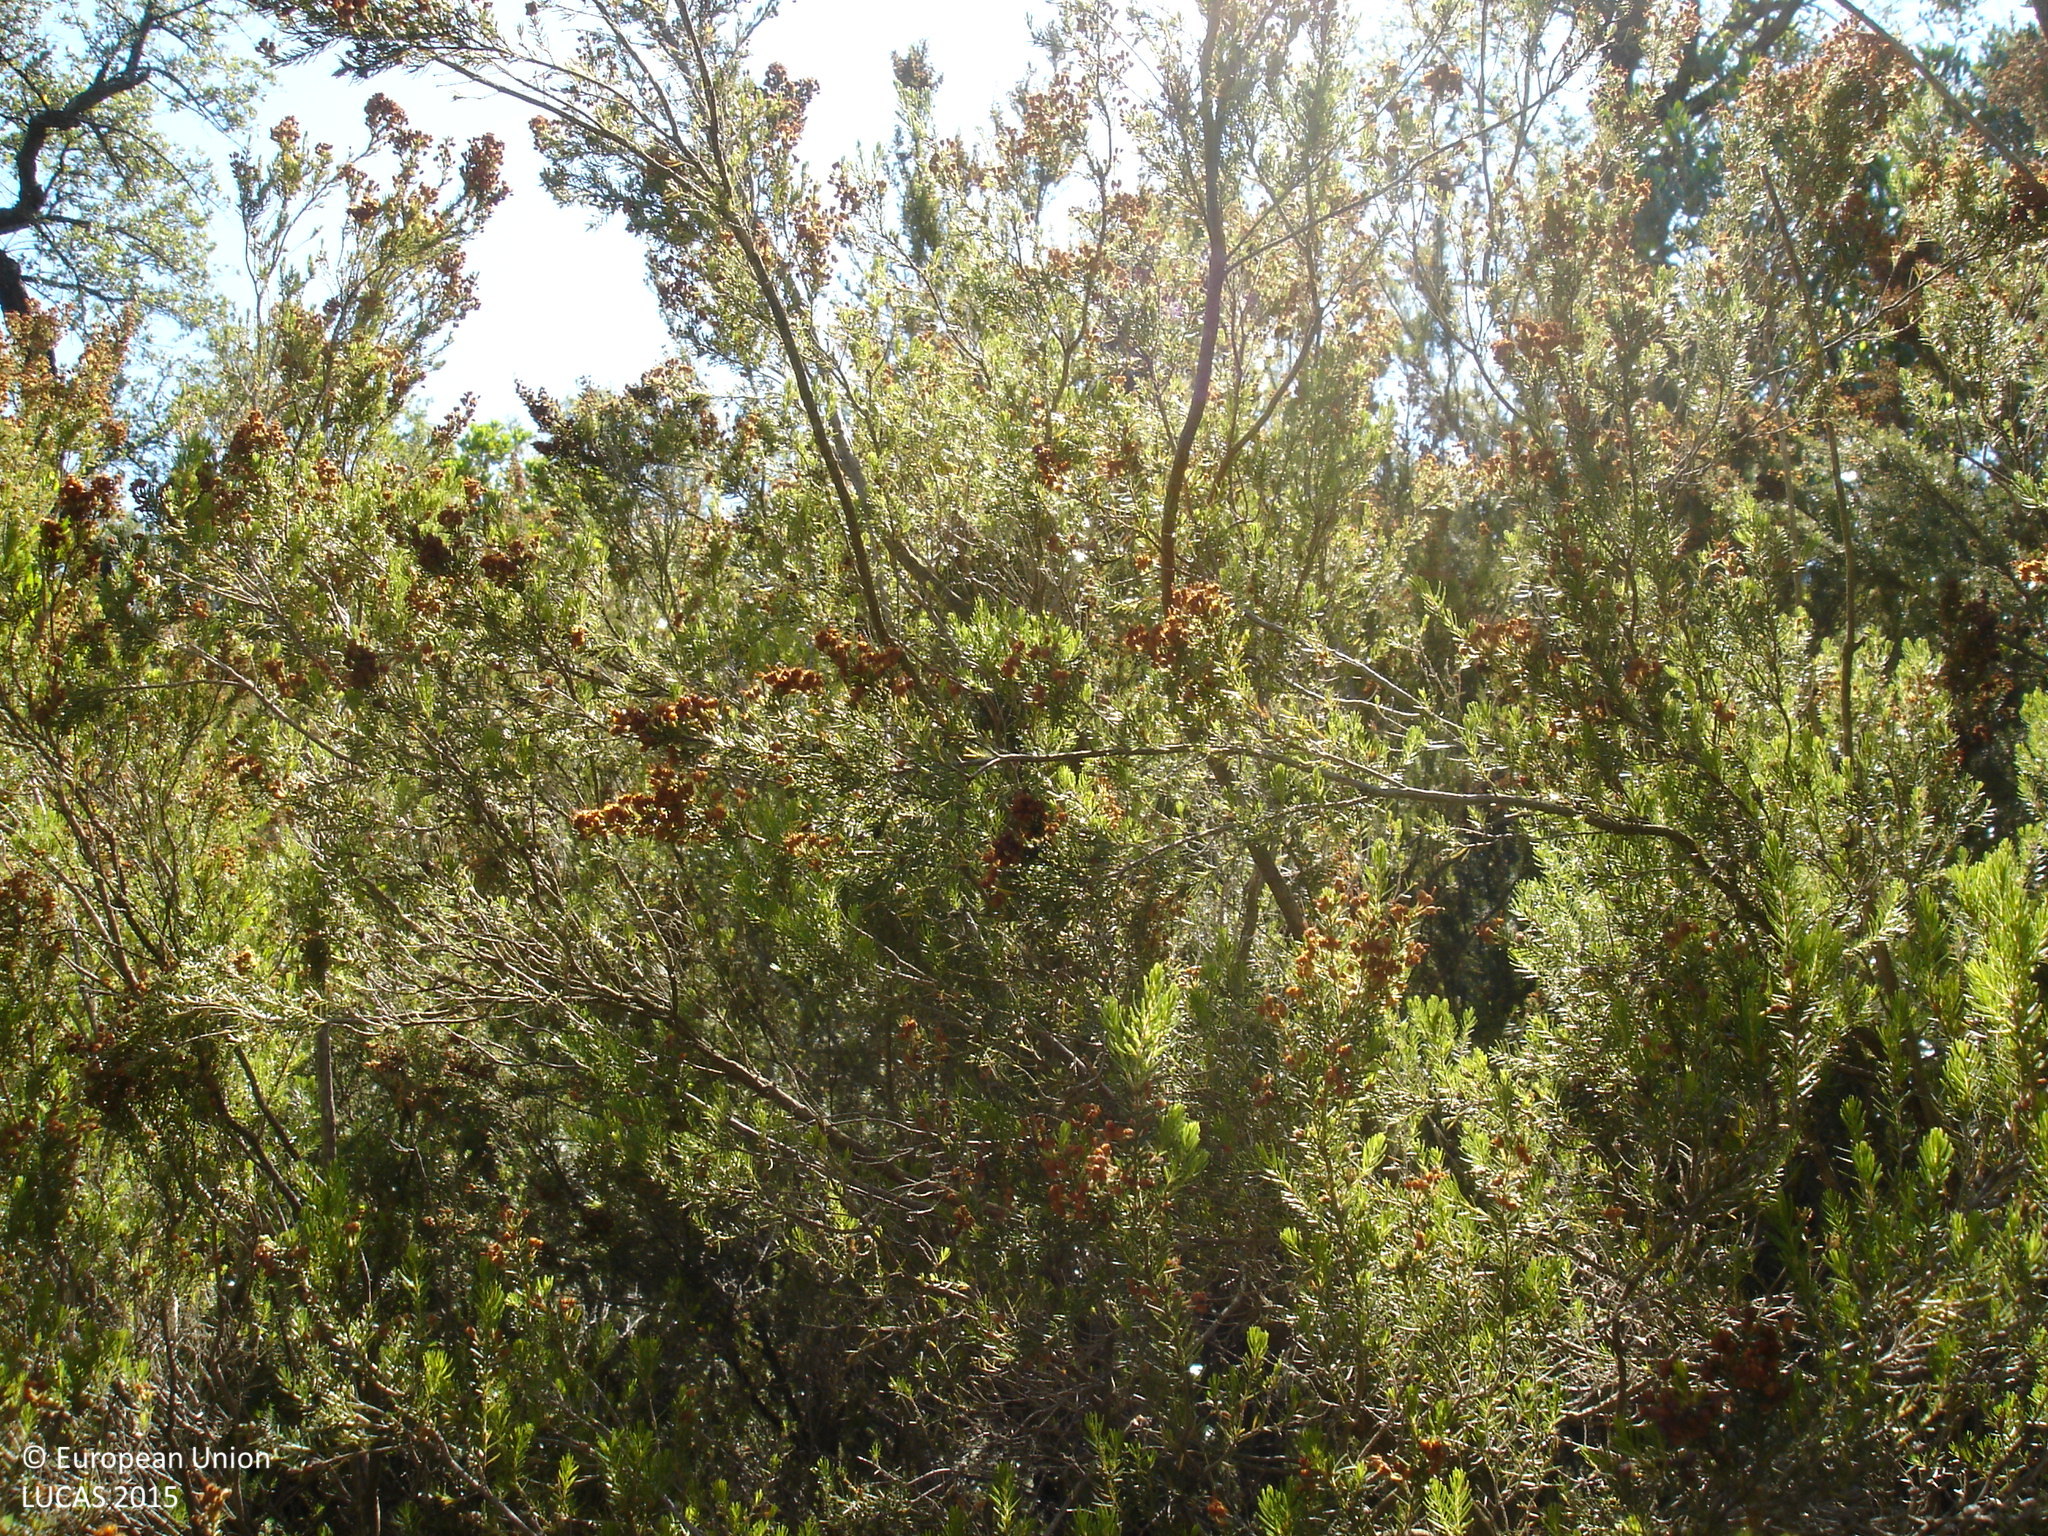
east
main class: Woodland
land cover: Broadleaved woodland
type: thermophilous deciduous forest
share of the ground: > 75 %
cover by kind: broadleaved forest trees 75 %, herbaceous plants 25 %
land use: Forestry
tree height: > 5 m
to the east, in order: Broadleaved woodland; Tracks; Shrubland with sparse tree cover; Broadleaved woodland; Tracks; Broadleaved woodland; Tracks; Grass margins; Broadleaved woodland; Tracks; Broadleaved woodland
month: June
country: ES
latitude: 41.7662
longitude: 2.5947
